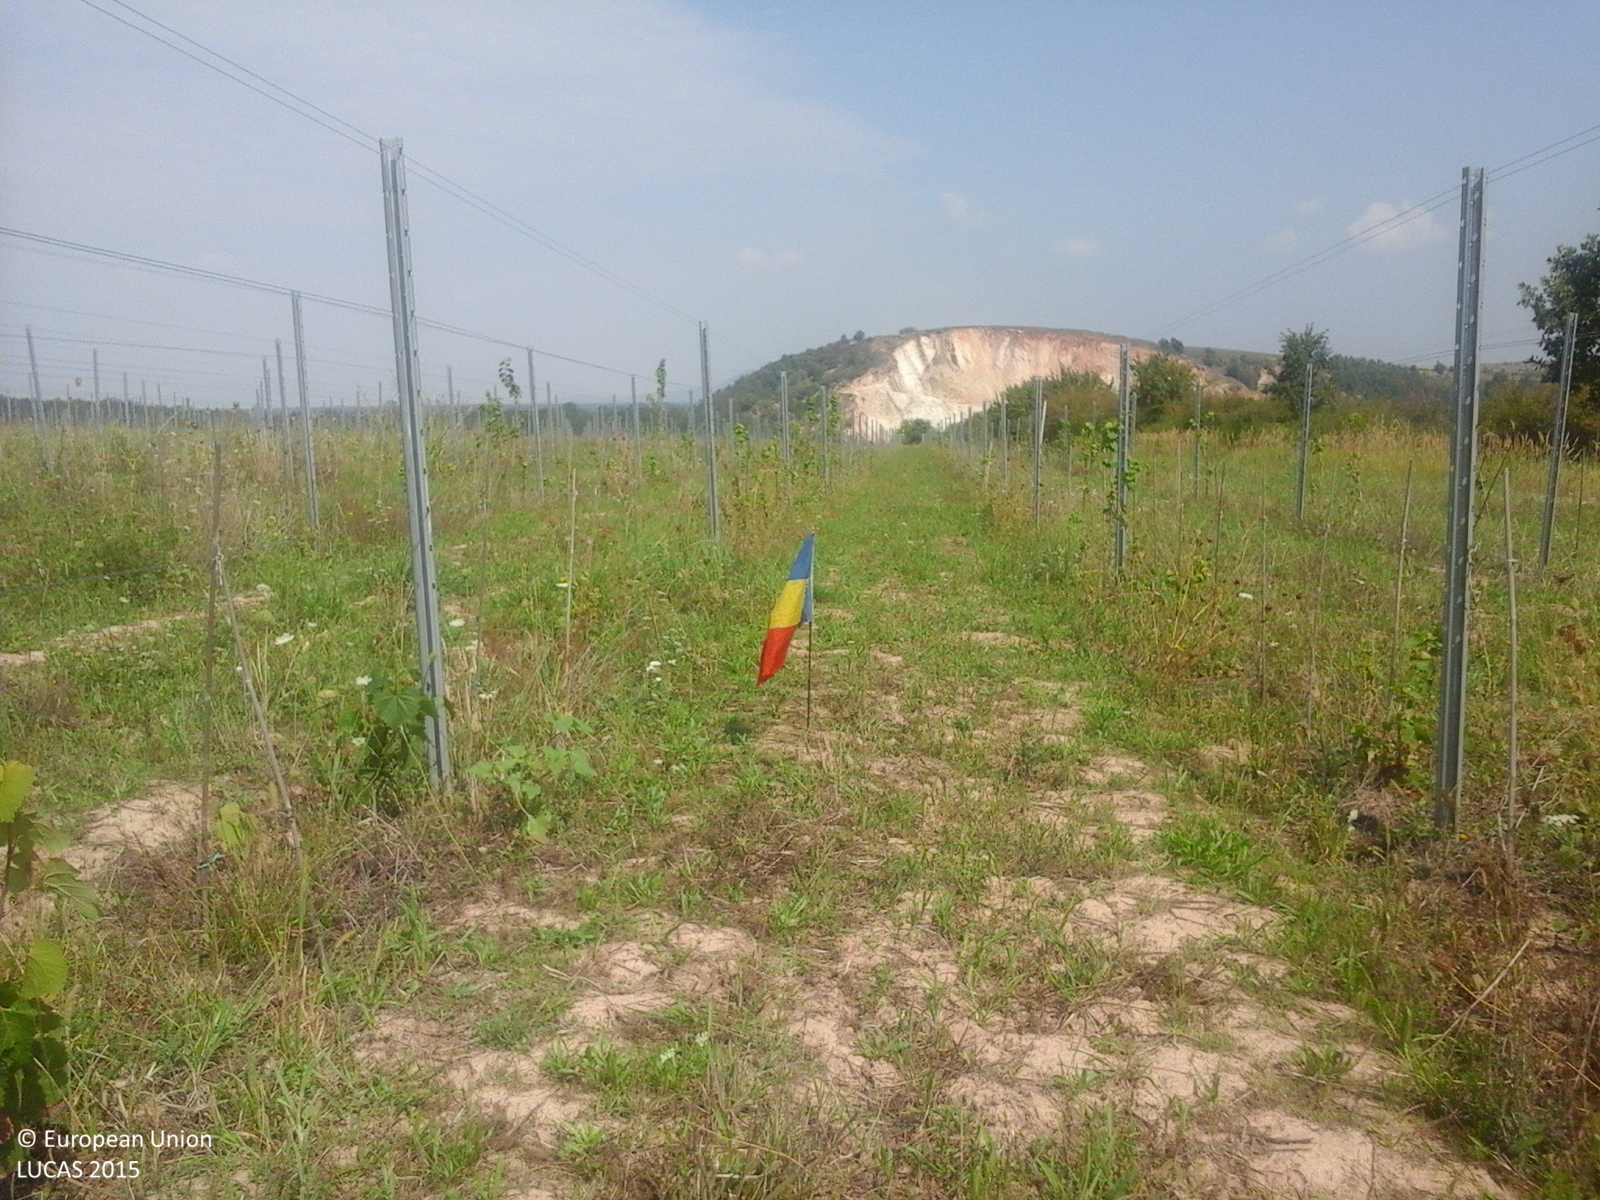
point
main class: Cropland
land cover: Vineyards
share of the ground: 10 - 25 %
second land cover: Grassland without tree/shrub cover
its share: > 75 %
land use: Agriculture (excluding fallow land and kitchen gardens)
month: August
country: RO
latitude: 46.2708
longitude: 21.8622
